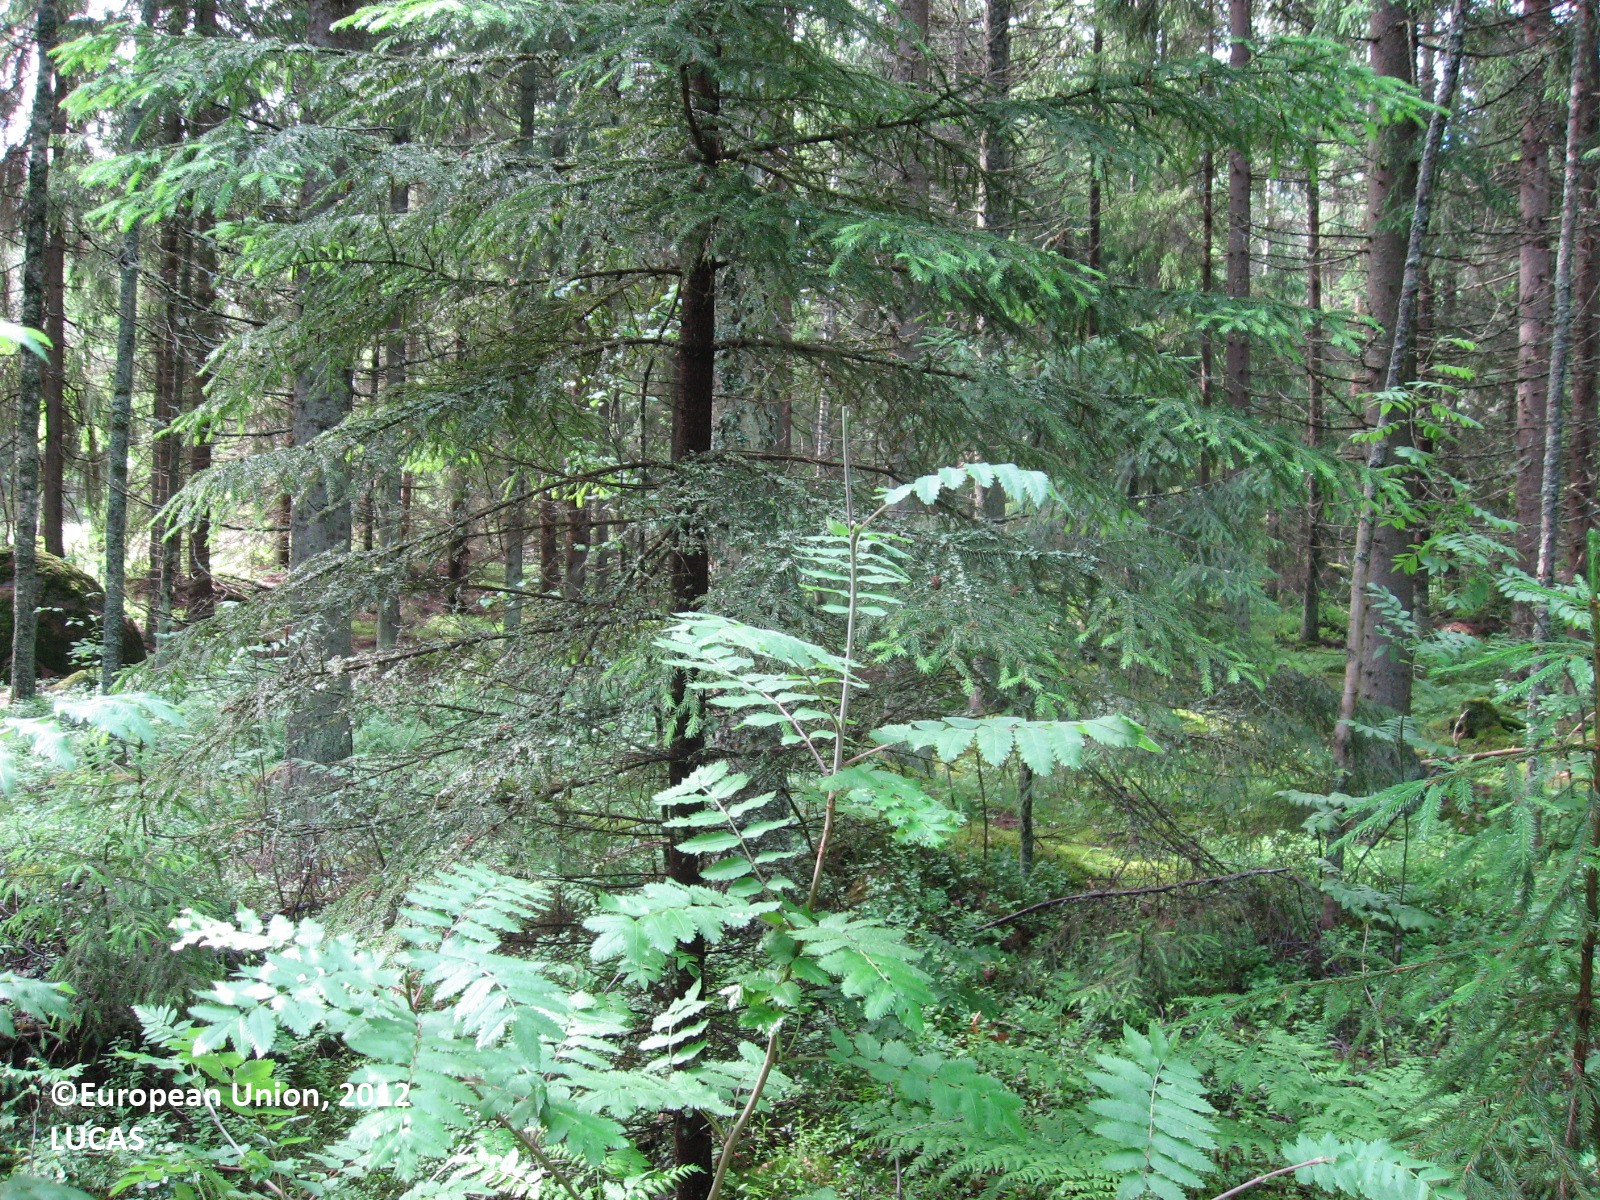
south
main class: Woodland
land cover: Spruce dominated coniferous woodland
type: boreal forest
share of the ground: 50 - 75 %
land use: Forestry
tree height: > 5 m
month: June
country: FI
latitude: 60.5706
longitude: 26.4469
